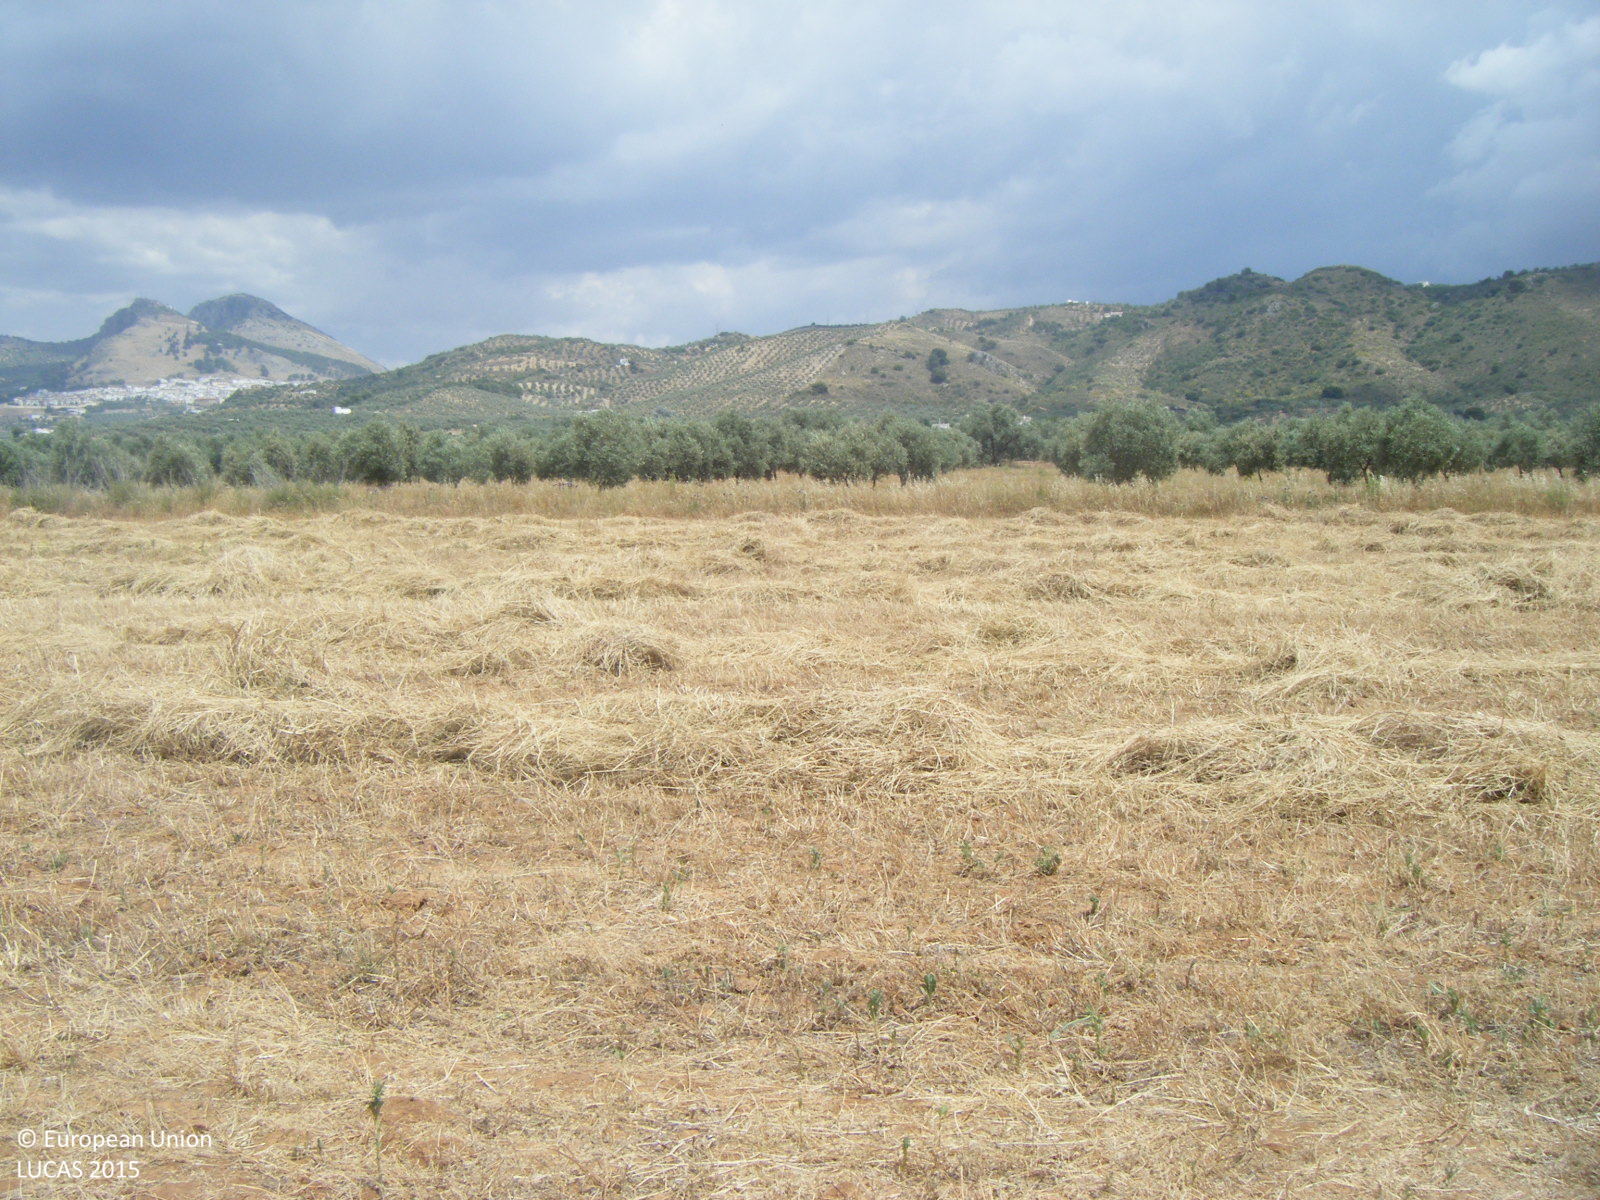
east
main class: Cropland
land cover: Olive groves
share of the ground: < 10 %
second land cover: Other bare soil
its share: > 75 %
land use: Agriculture (excluding fallow land and kitchen gardens)
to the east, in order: Olive groves; Other bare soil; Fences; Oats; Olive groves
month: May
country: ES
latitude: 37.0822
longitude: -4.4289
